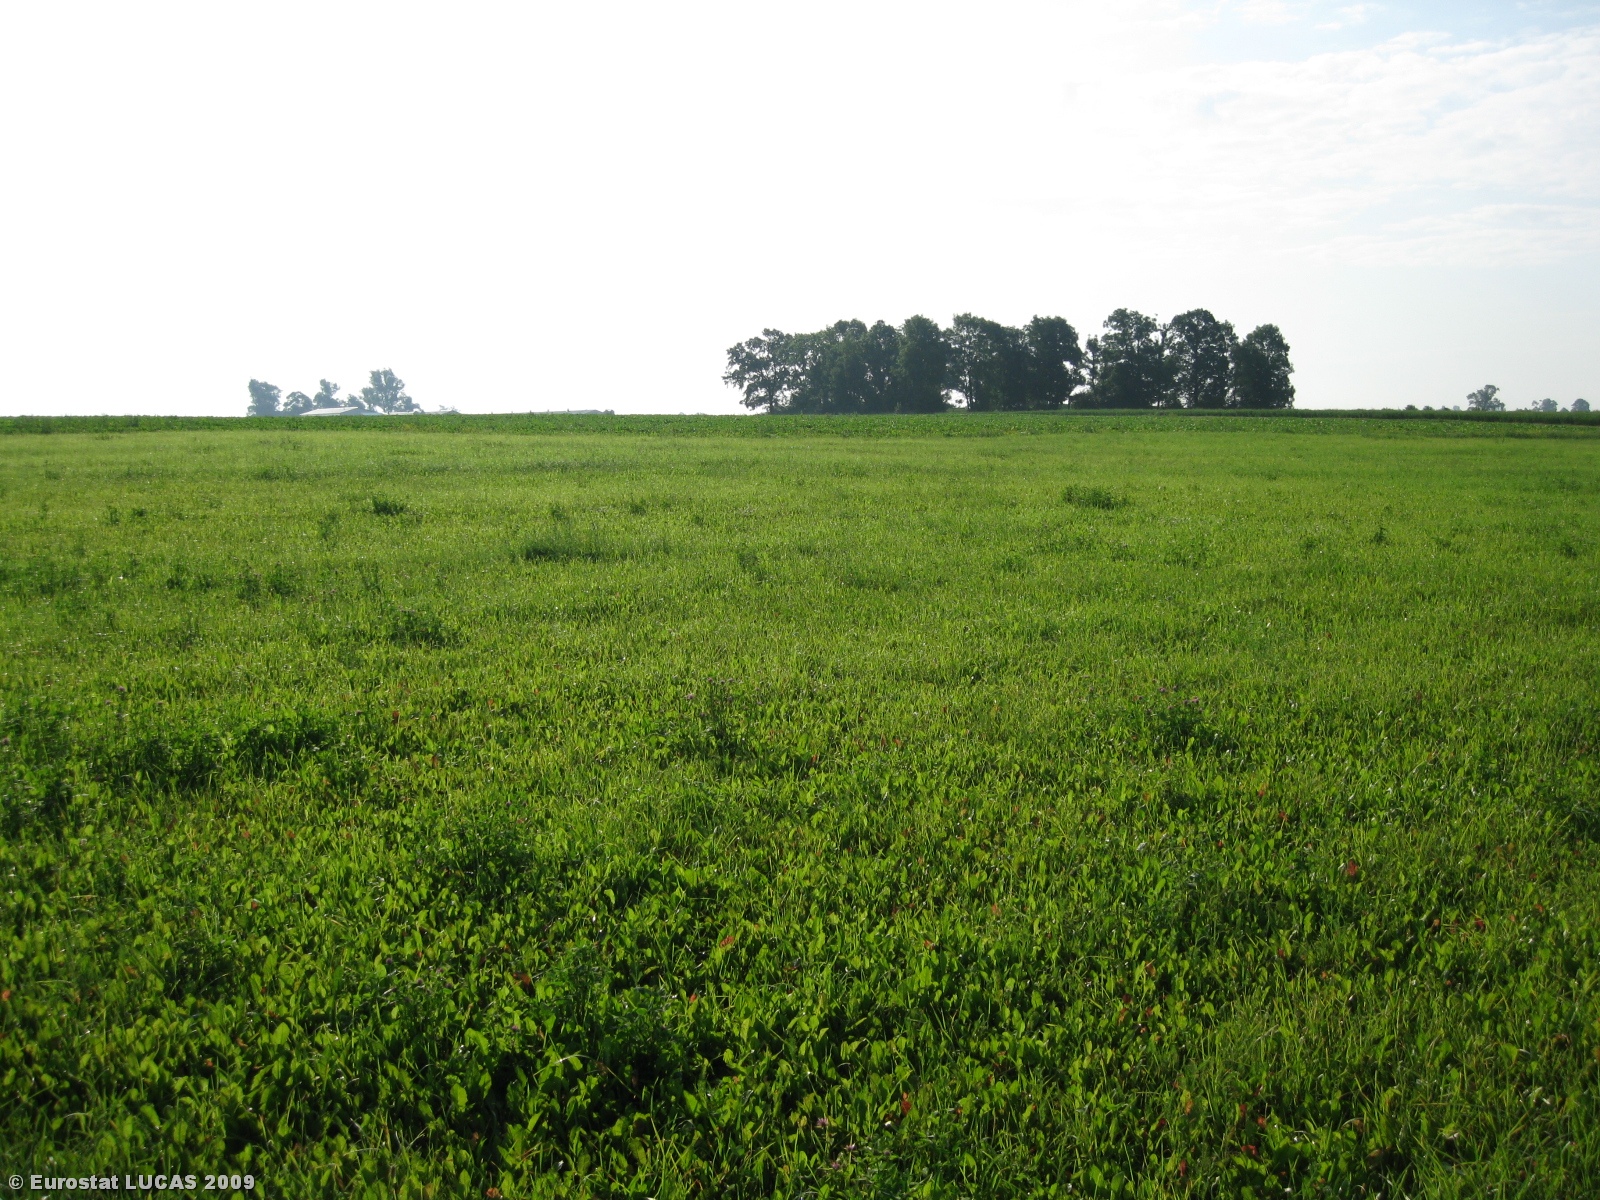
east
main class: Grassland
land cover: Grassland without tree/shrub cover
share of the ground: > 75 %
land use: Agriculture (excluding fallow land and kitchen gardens)
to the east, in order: Grassland without tree/shrub cover; Sugar beet
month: July
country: LT
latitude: 54.5651
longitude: 23.4275
